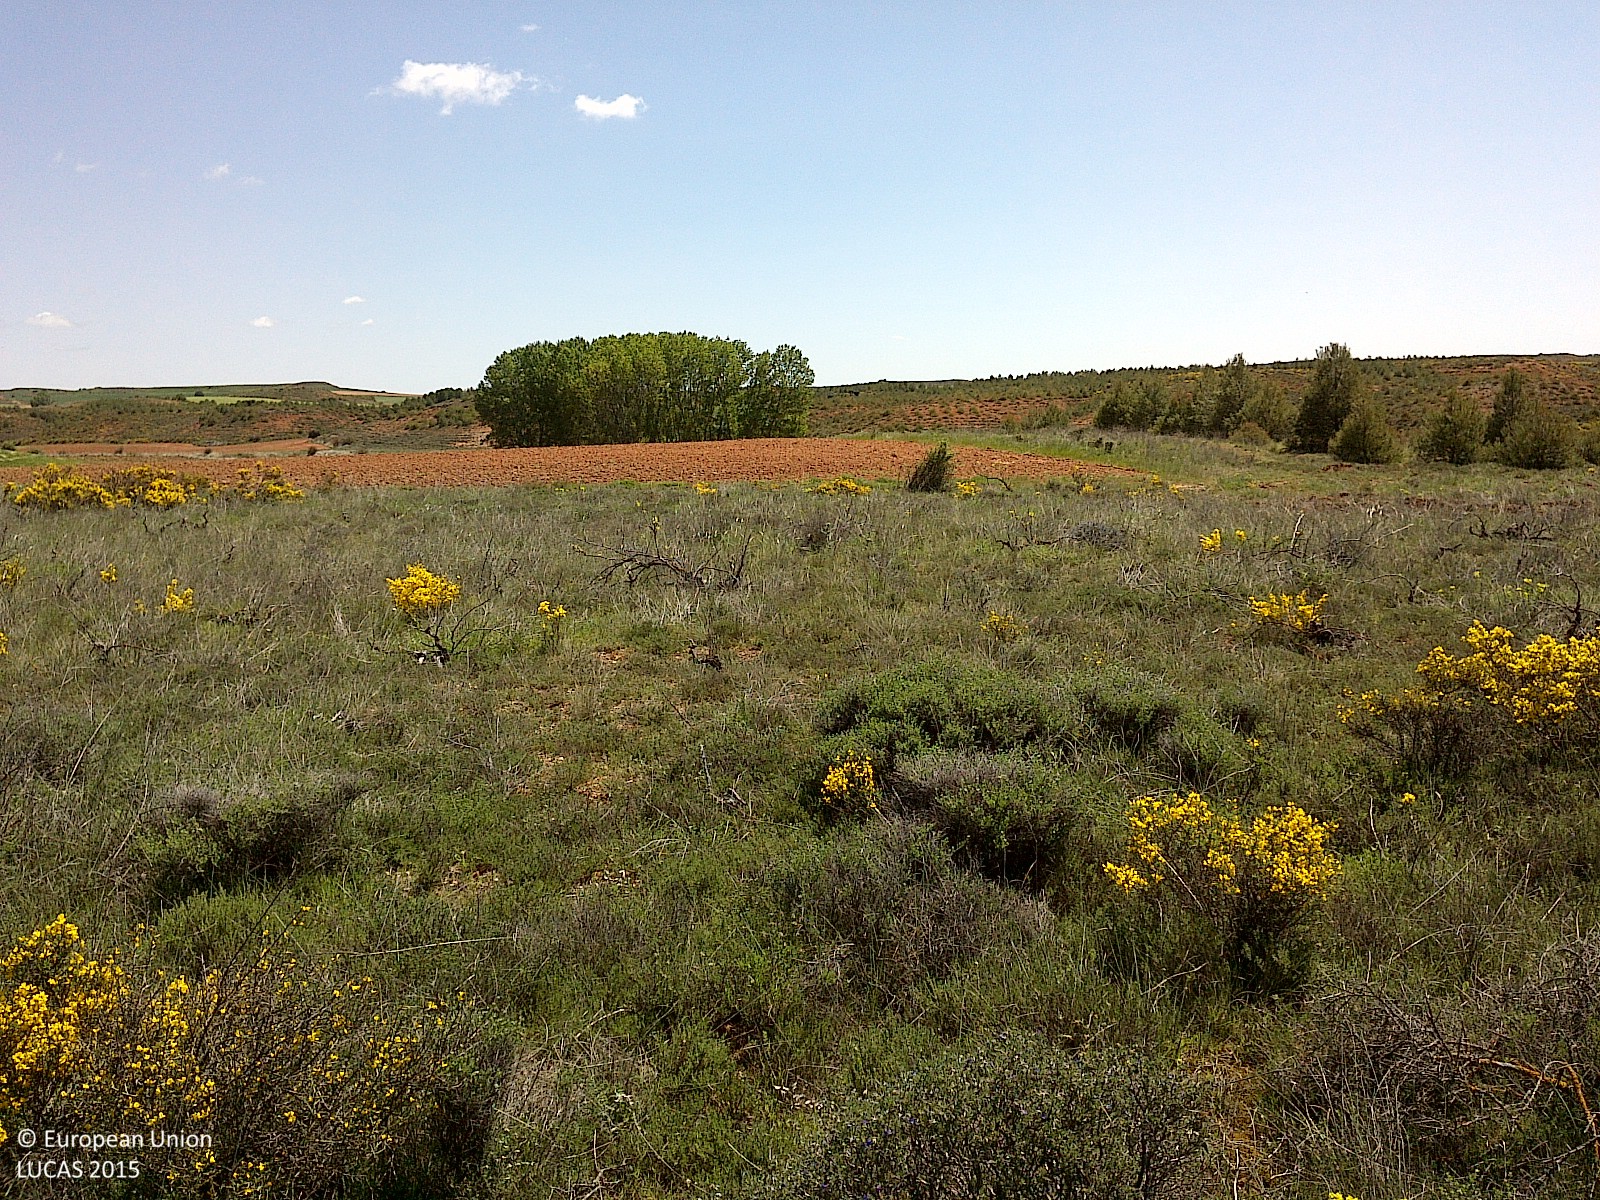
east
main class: Shrubland
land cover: Shrubland with sparse tree cover
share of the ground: 50 - 75 %
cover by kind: shrubs 65 %, herbaceous plants 20 %, unconsolidated bare surface 10 %, coniferous forest trees 5 %
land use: Semi-natural and natural areas not in use
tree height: < 5 m
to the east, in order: Shrubland with sparse tree cover; Tracks; Other bare soil; Grass margins; Rivers and streams; Grass margins; Other bare soil
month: May
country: ES
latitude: 41.6021
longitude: -3.2075
